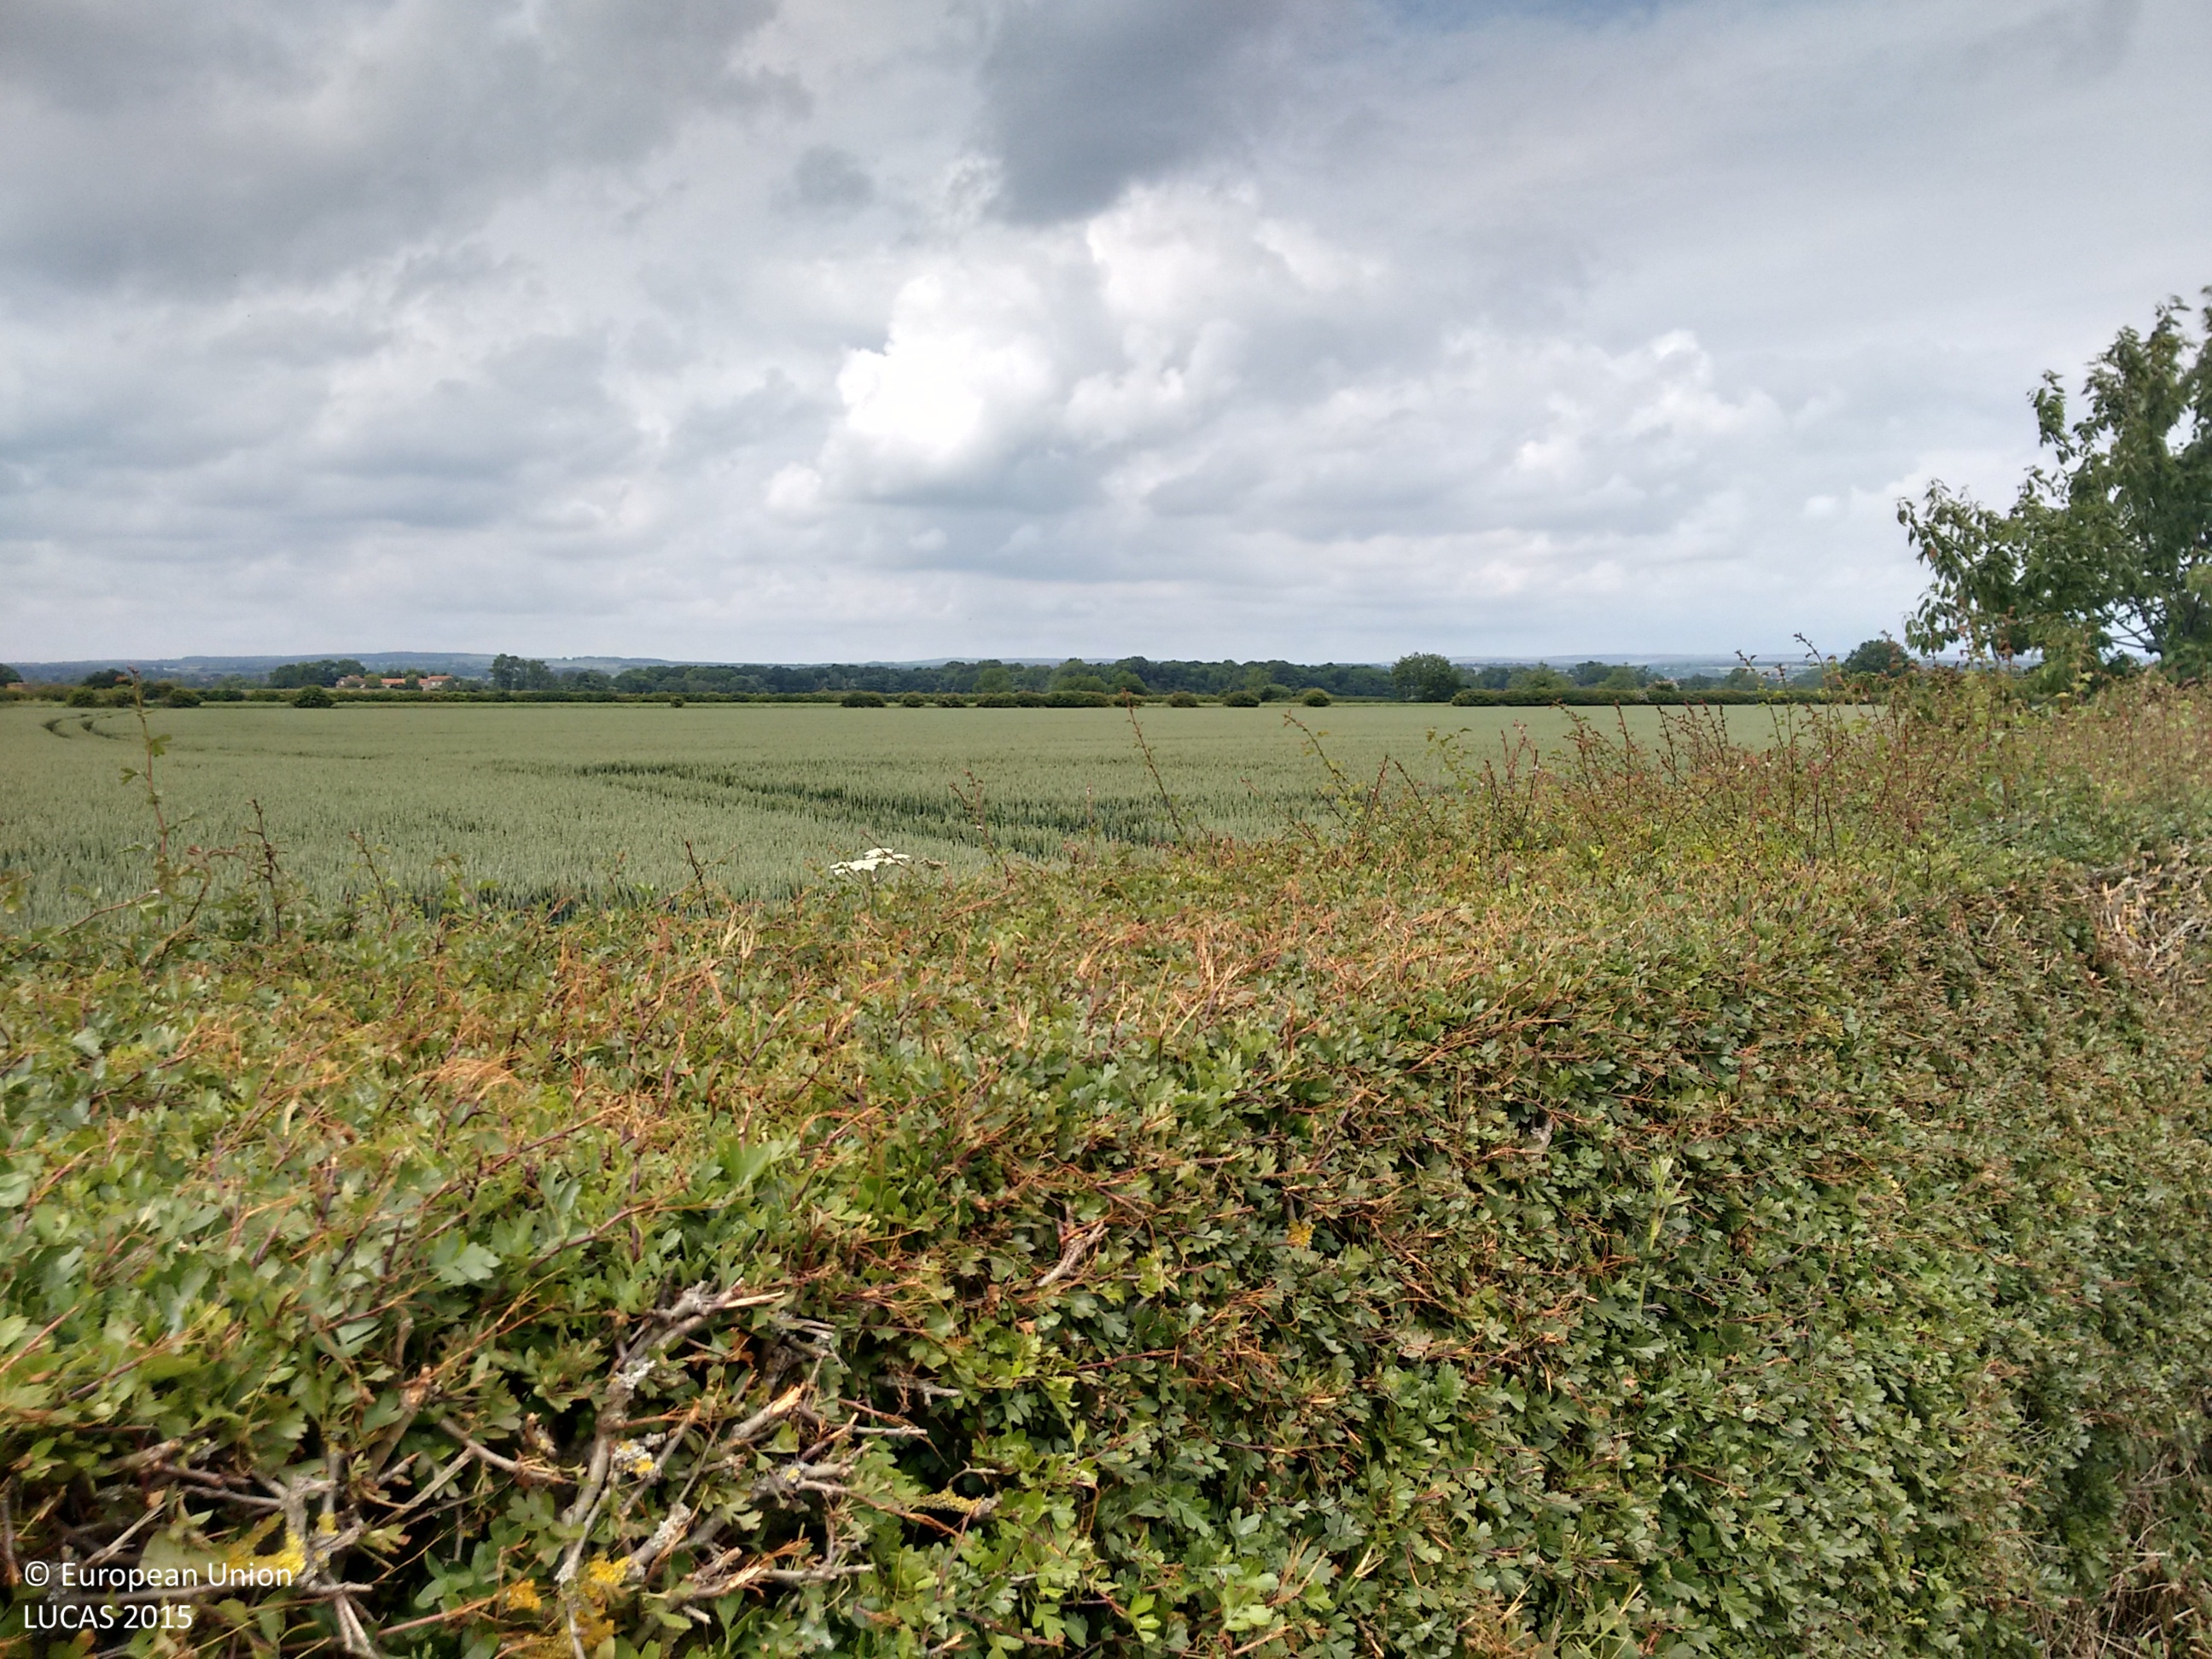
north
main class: Cropland
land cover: Common wheat
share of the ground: > 75 %
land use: Agriculture (excluding fallow land and kitchen gardens)
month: June
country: GB
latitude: 54.2289
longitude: -0.9483
